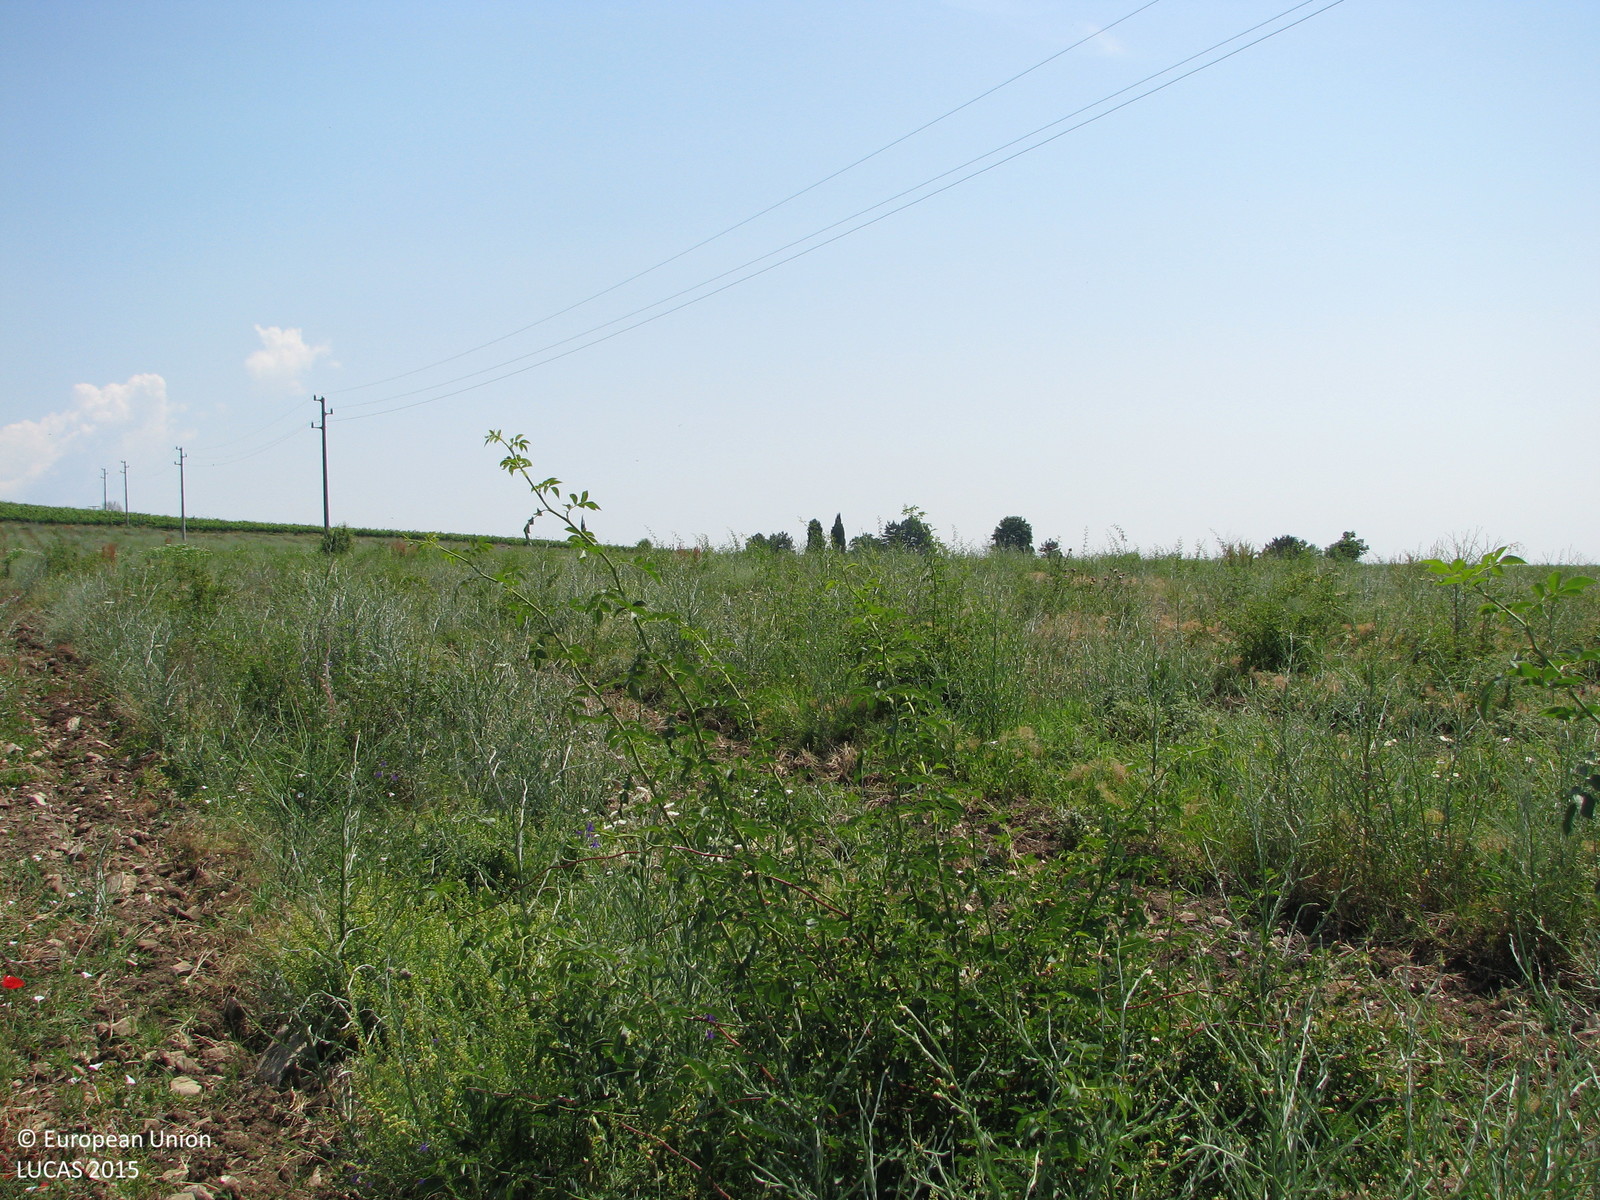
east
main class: Cropland
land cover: Other fruit trees and berries
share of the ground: < 10 %
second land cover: Spontaneously vegetated surfaces
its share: > 75 %
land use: Agriculture (excluding fallow land and kitchen gardens)
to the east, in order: Other fruit trees and berries; Spontaneously vegetated surfaces; Electric lines; Other fruit trees and berries; Other bare soil; Other fruit trees and berries; Rye; Common wheat; Rye; Grassland with sparse tree/shrub cover
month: June
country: BG
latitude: 42.6059
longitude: 26.2131
